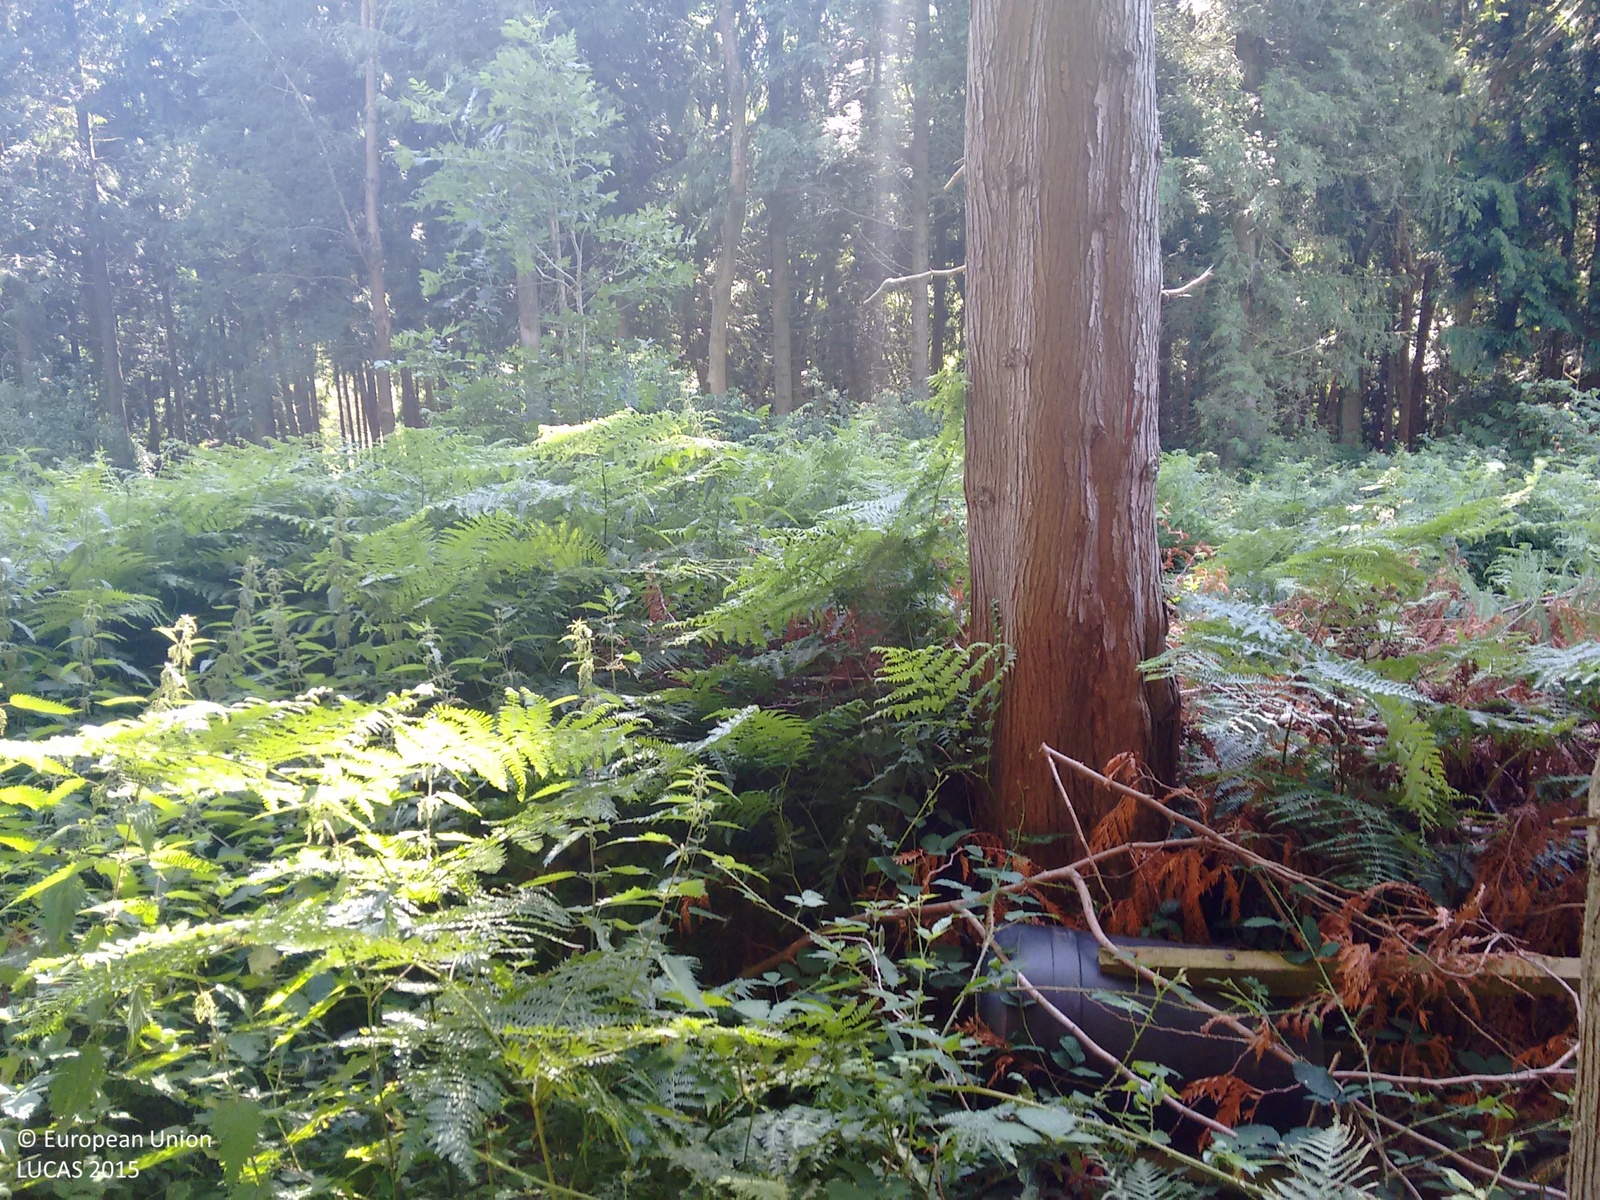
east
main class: Woodland
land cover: Other coniferous woodland
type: exotic forest
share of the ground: > 75 %
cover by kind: coniferous forest trees 100 %
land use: Forestry
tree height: > 5 m
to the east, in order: Other coniferous woodland; Electric lines; Other coniferous woodland; Tracks; Broadleaved woodland; Paved roads, cycling and walking lanes; Broadleaved woodland
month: July
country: GB
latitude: 50.9481
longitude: -0.9035
